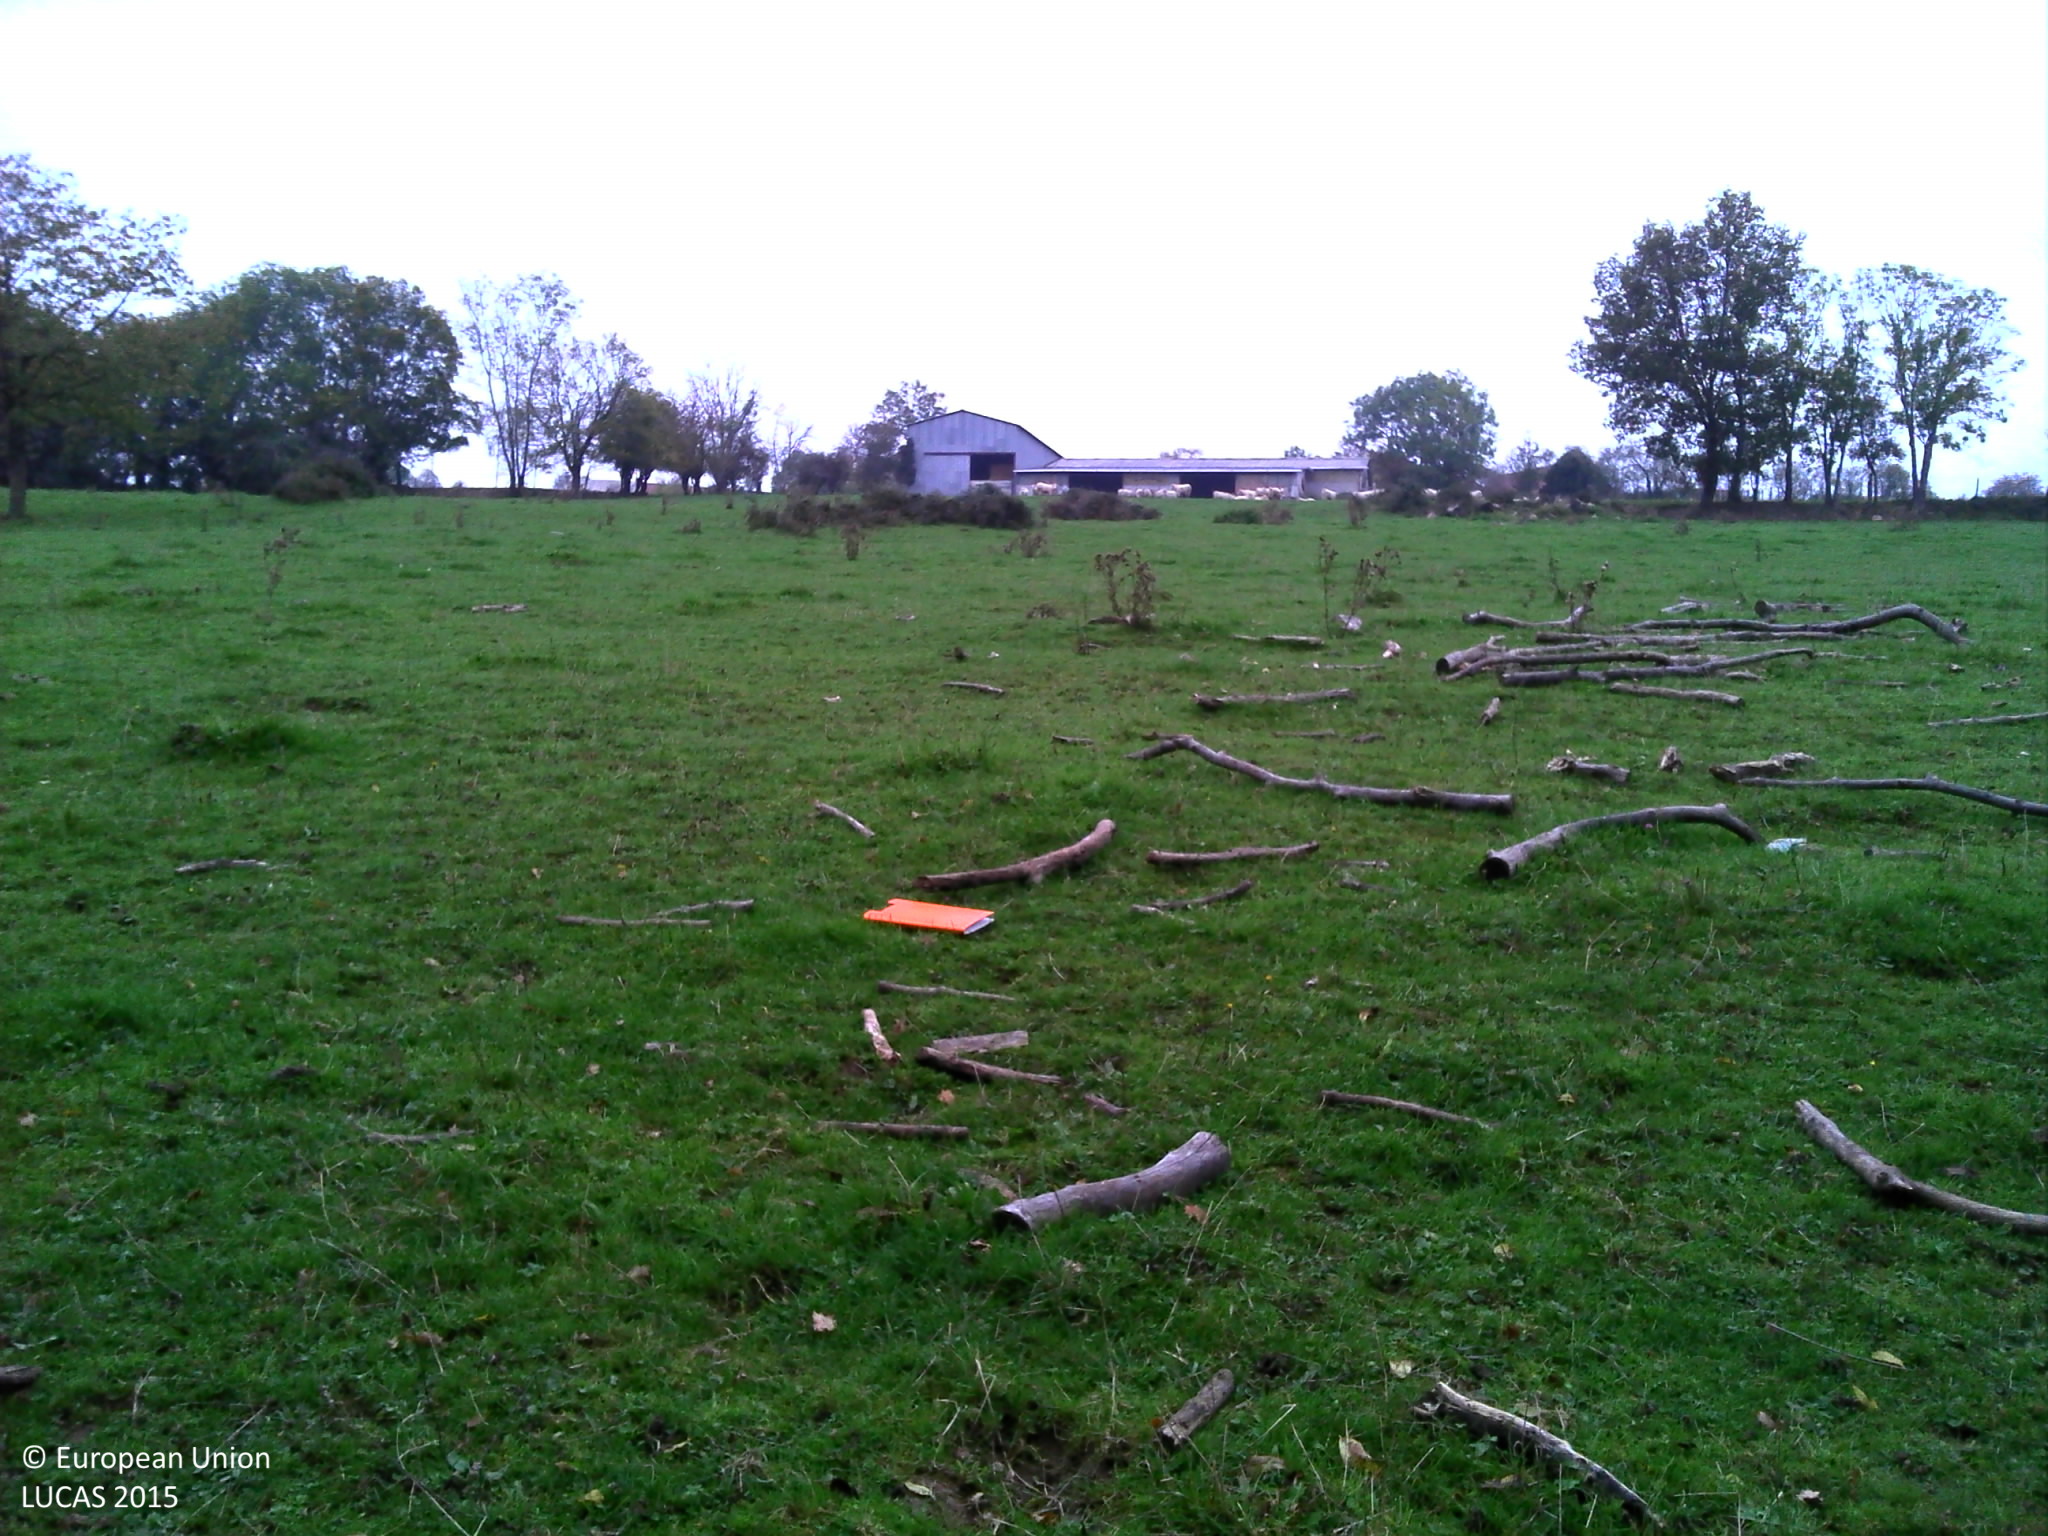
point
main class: Grassland
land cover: Grassland without tree/shrub cover
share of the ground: > 75 %
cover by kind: herbaceous plants 95 %, unconsolidated bare surface 5 %
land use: Agriculture (excluding fallow land and kitchen gardens)
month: October
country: FR
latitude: 45.9978
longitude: 3.0393
